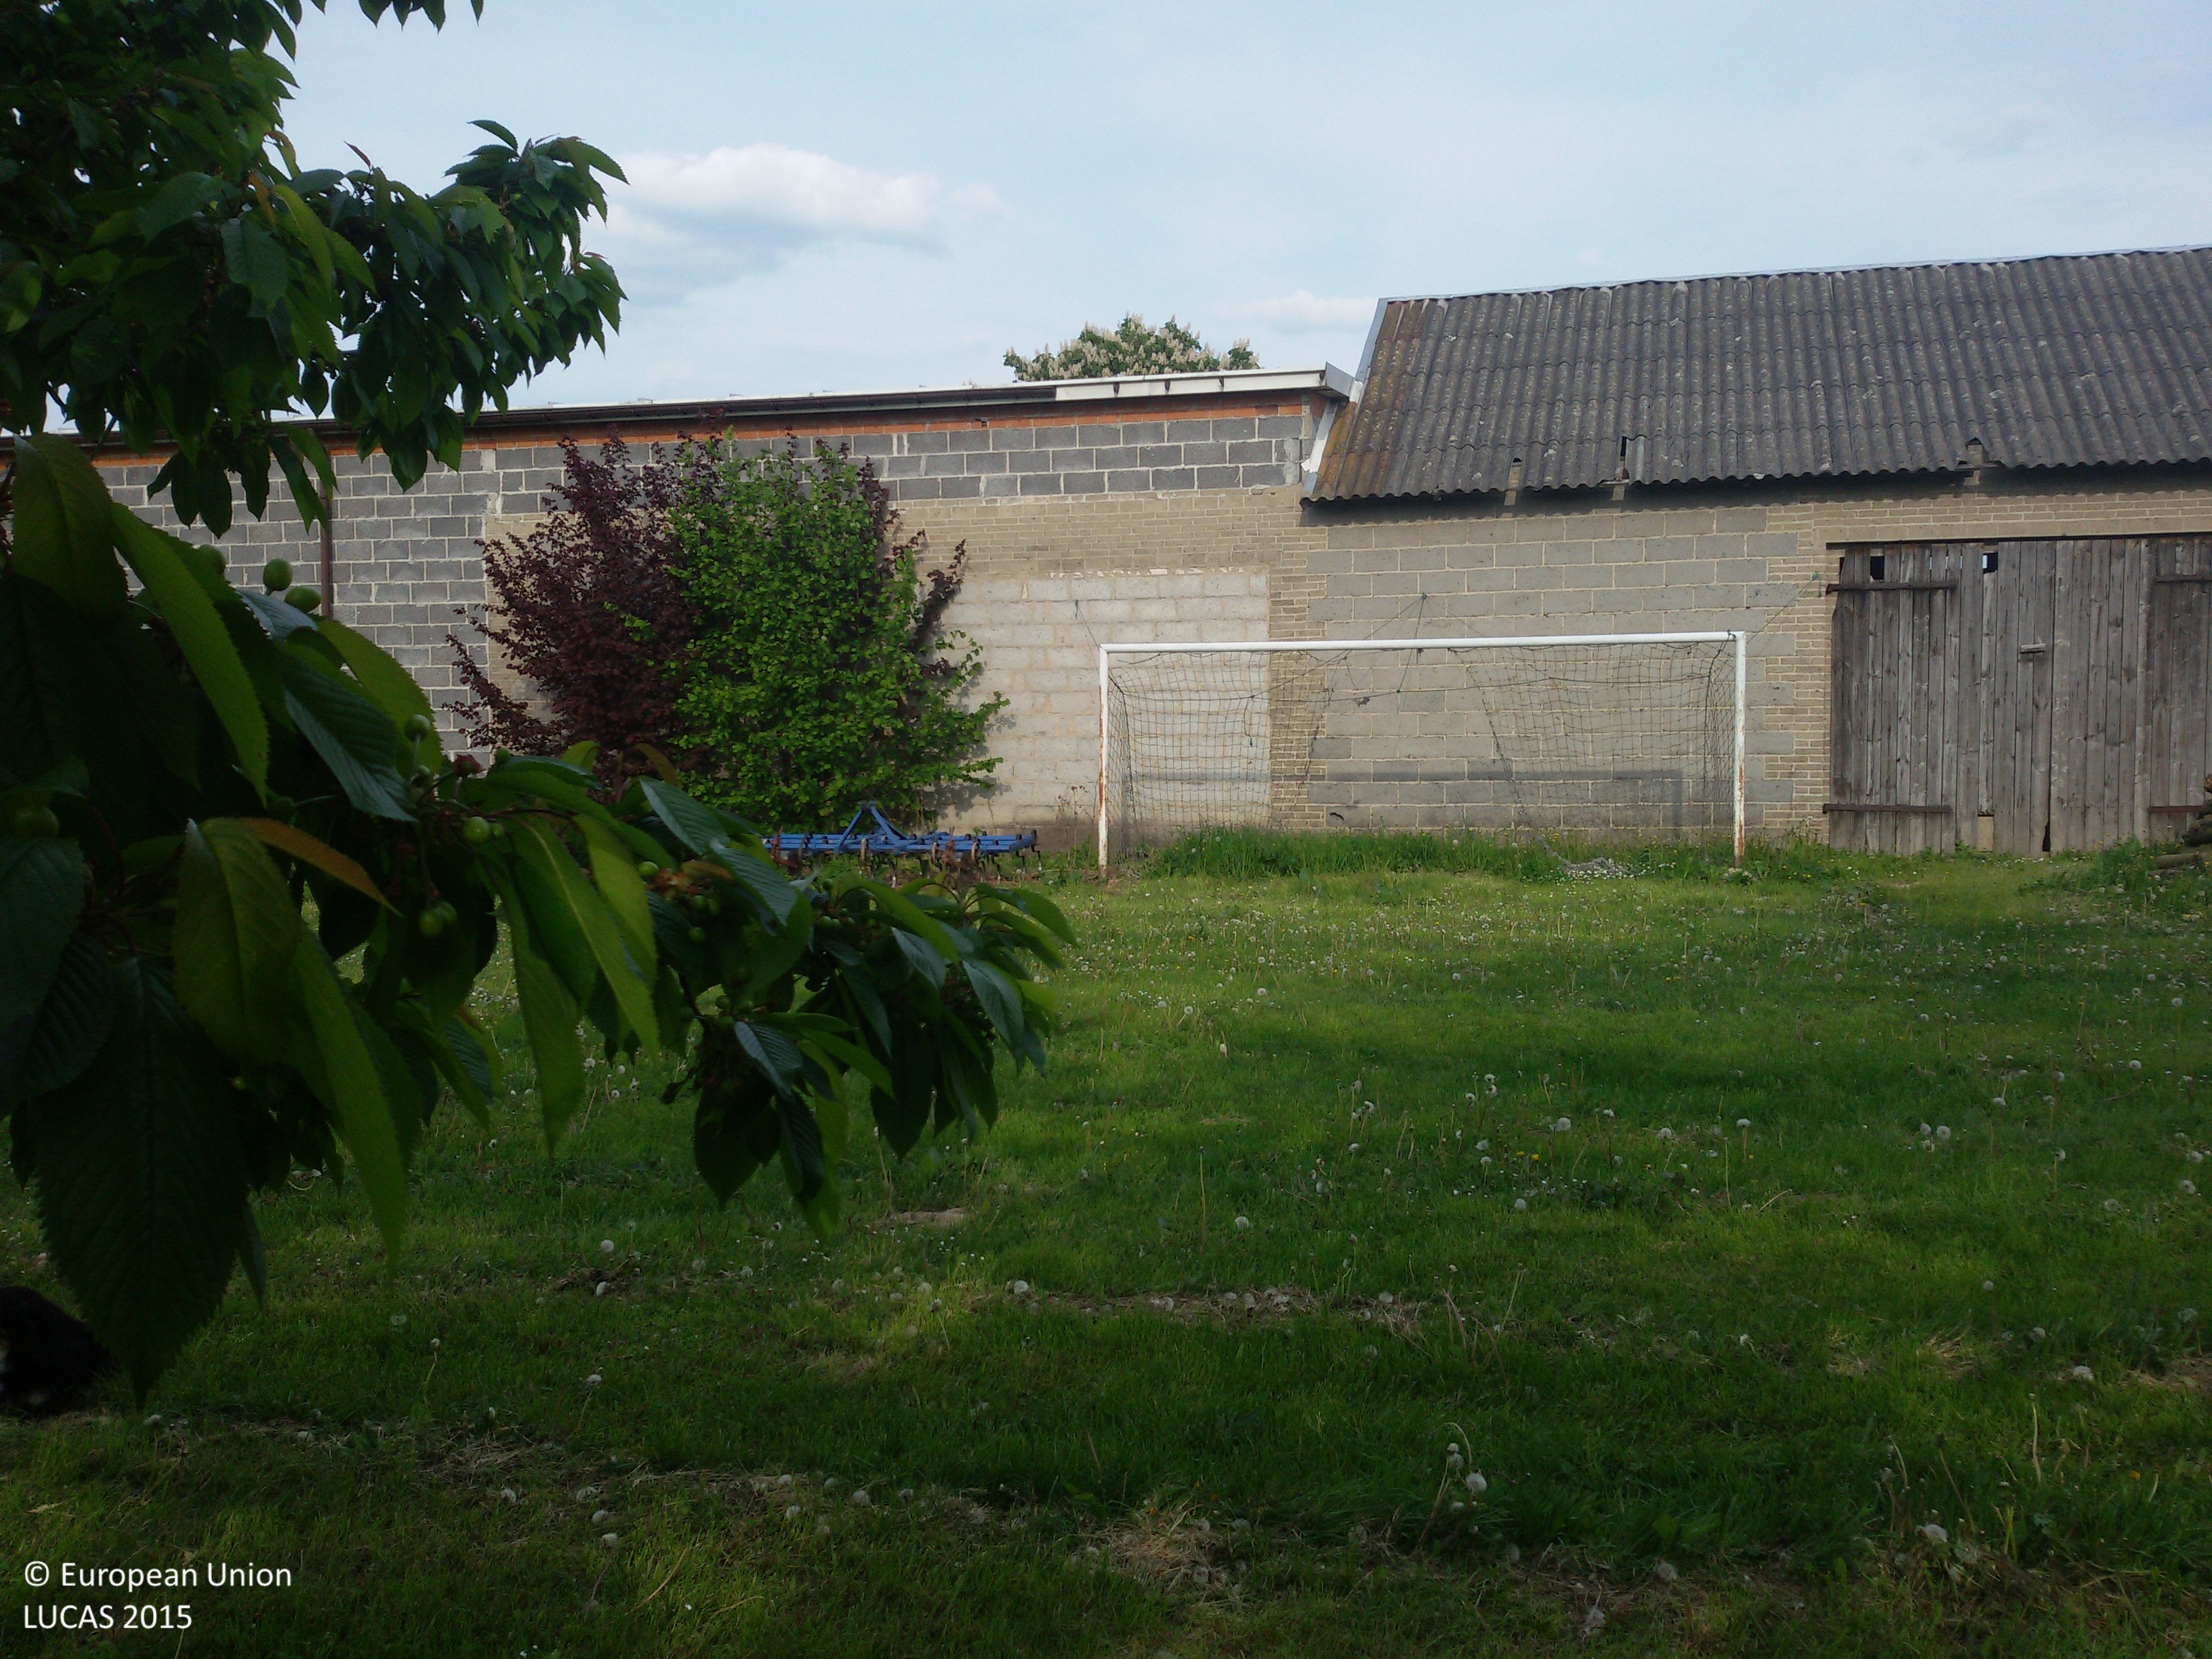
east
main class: Cropland
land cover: Cherry fruit
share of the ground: 50 - 75 %
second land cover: Grassland without tree/shrub cover
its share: > 75 %
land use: Agriculture (excluding fallow land and kitchen gardens)
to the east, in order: Cherry fruit; Grassland without tree/shrub cover; Artificial constructions in urban areas; Apple fruit; Common wheat
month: May
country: PL
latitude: 51.9641
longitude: 20.7090
